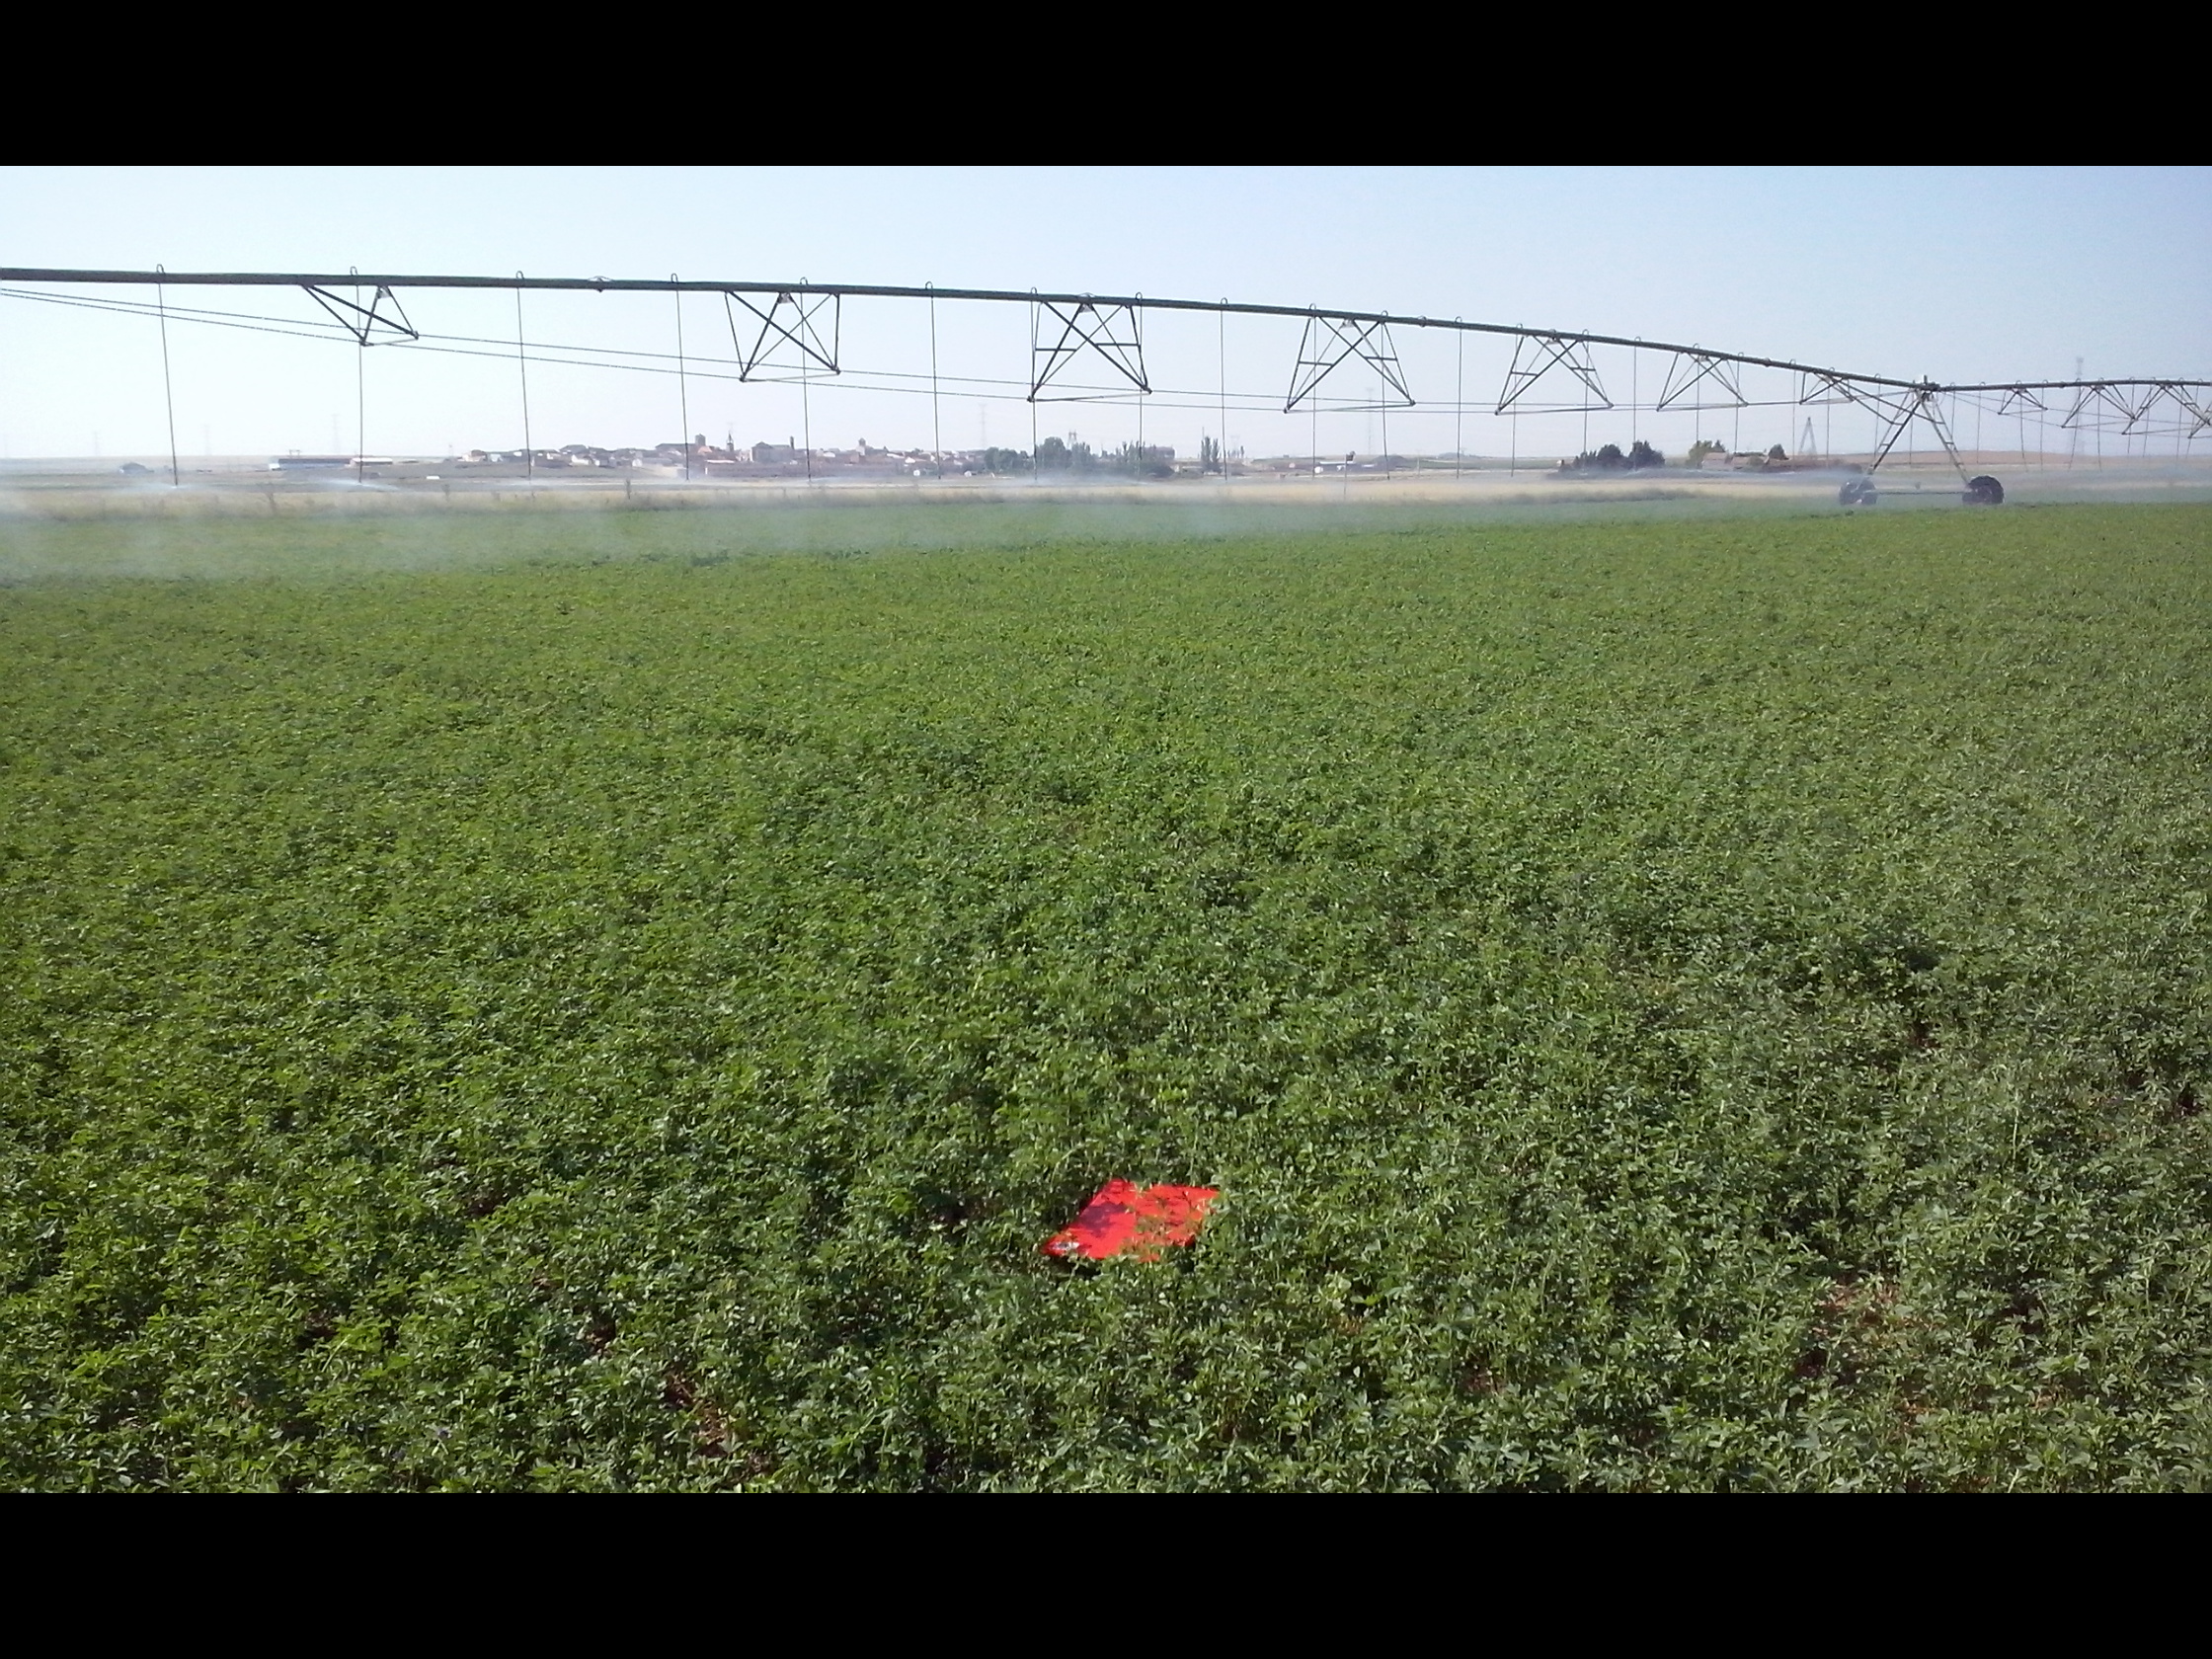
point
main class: Cropland
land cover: Lucerne
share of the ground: > 75 %
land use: Agriculture (excluding fallow land and kitchen gardens)
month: July
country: ES
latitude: 41.5621
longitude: -5.1482
